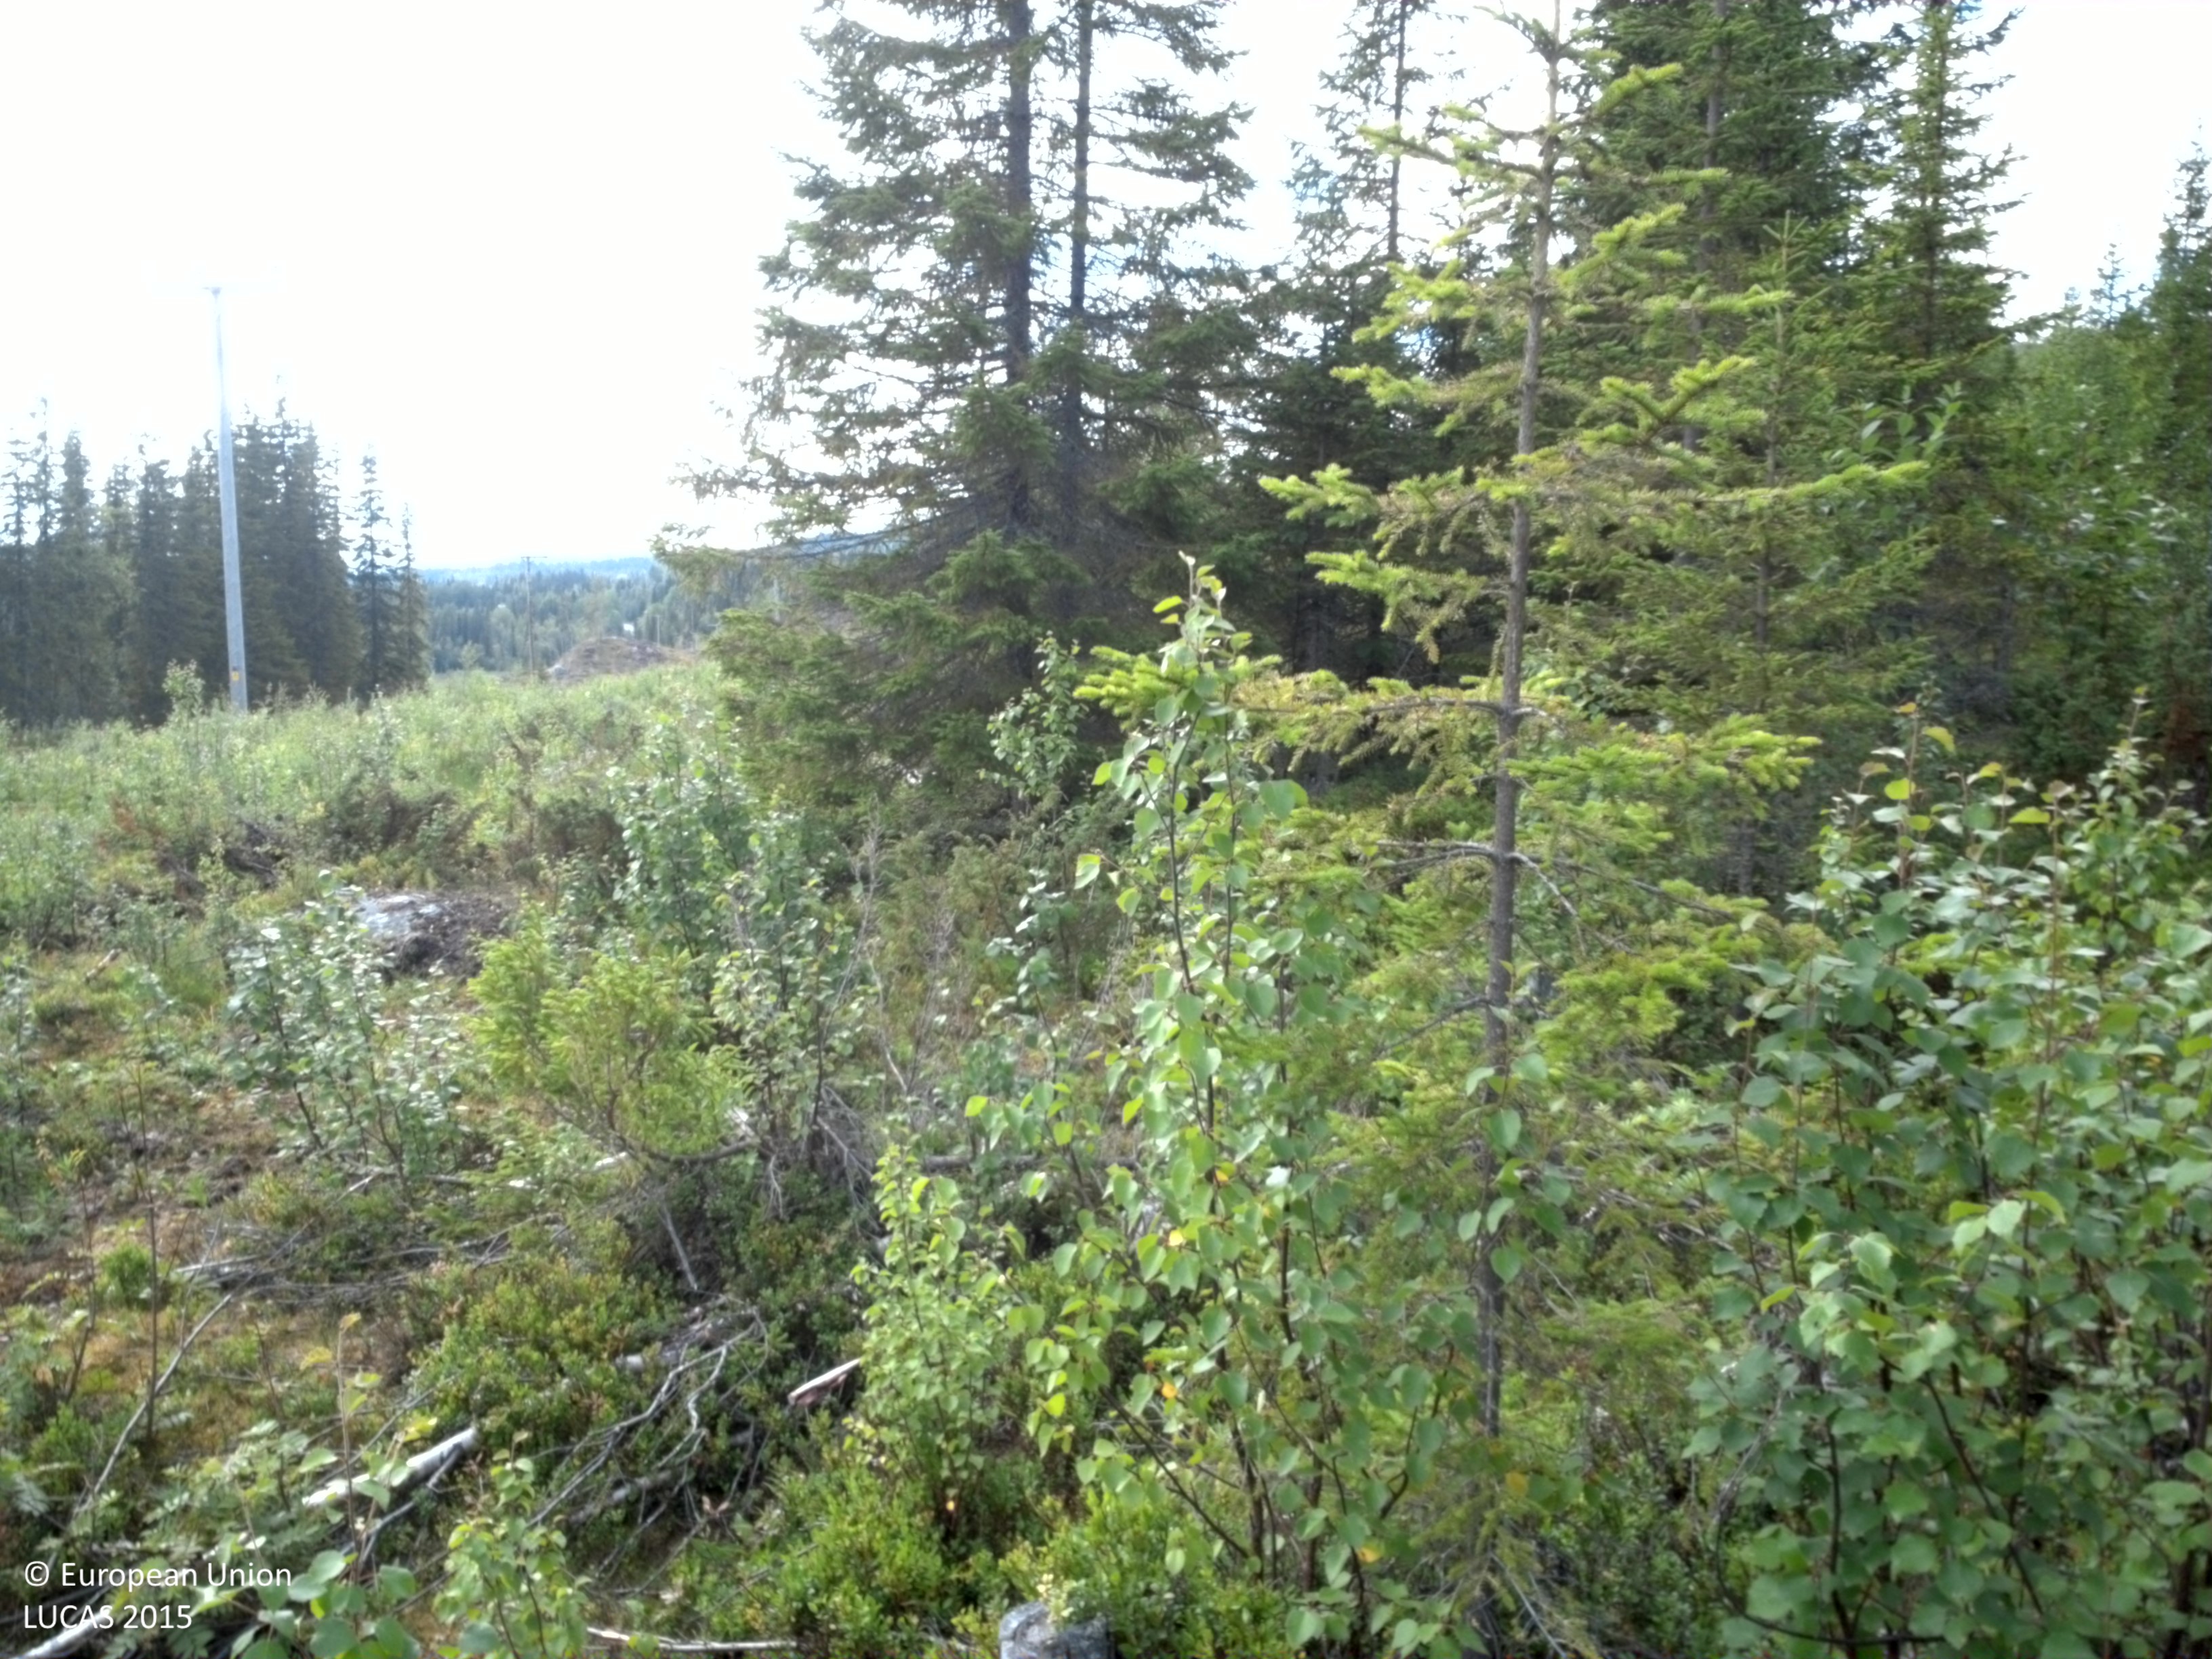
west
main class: Woodland
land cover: Spruce dominated mixed woodland
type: boreal forest
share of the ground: 25 - 50 %
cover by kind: shrubs 35 %, coniferous forest trees 25 %, lichens and mosses 20 %, broadleaved forest trees 15 %, herbaceous plants 5 %
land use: Forestry
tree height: > 5 m
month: August
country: SE
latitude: 64.9447
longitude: 15.7866
